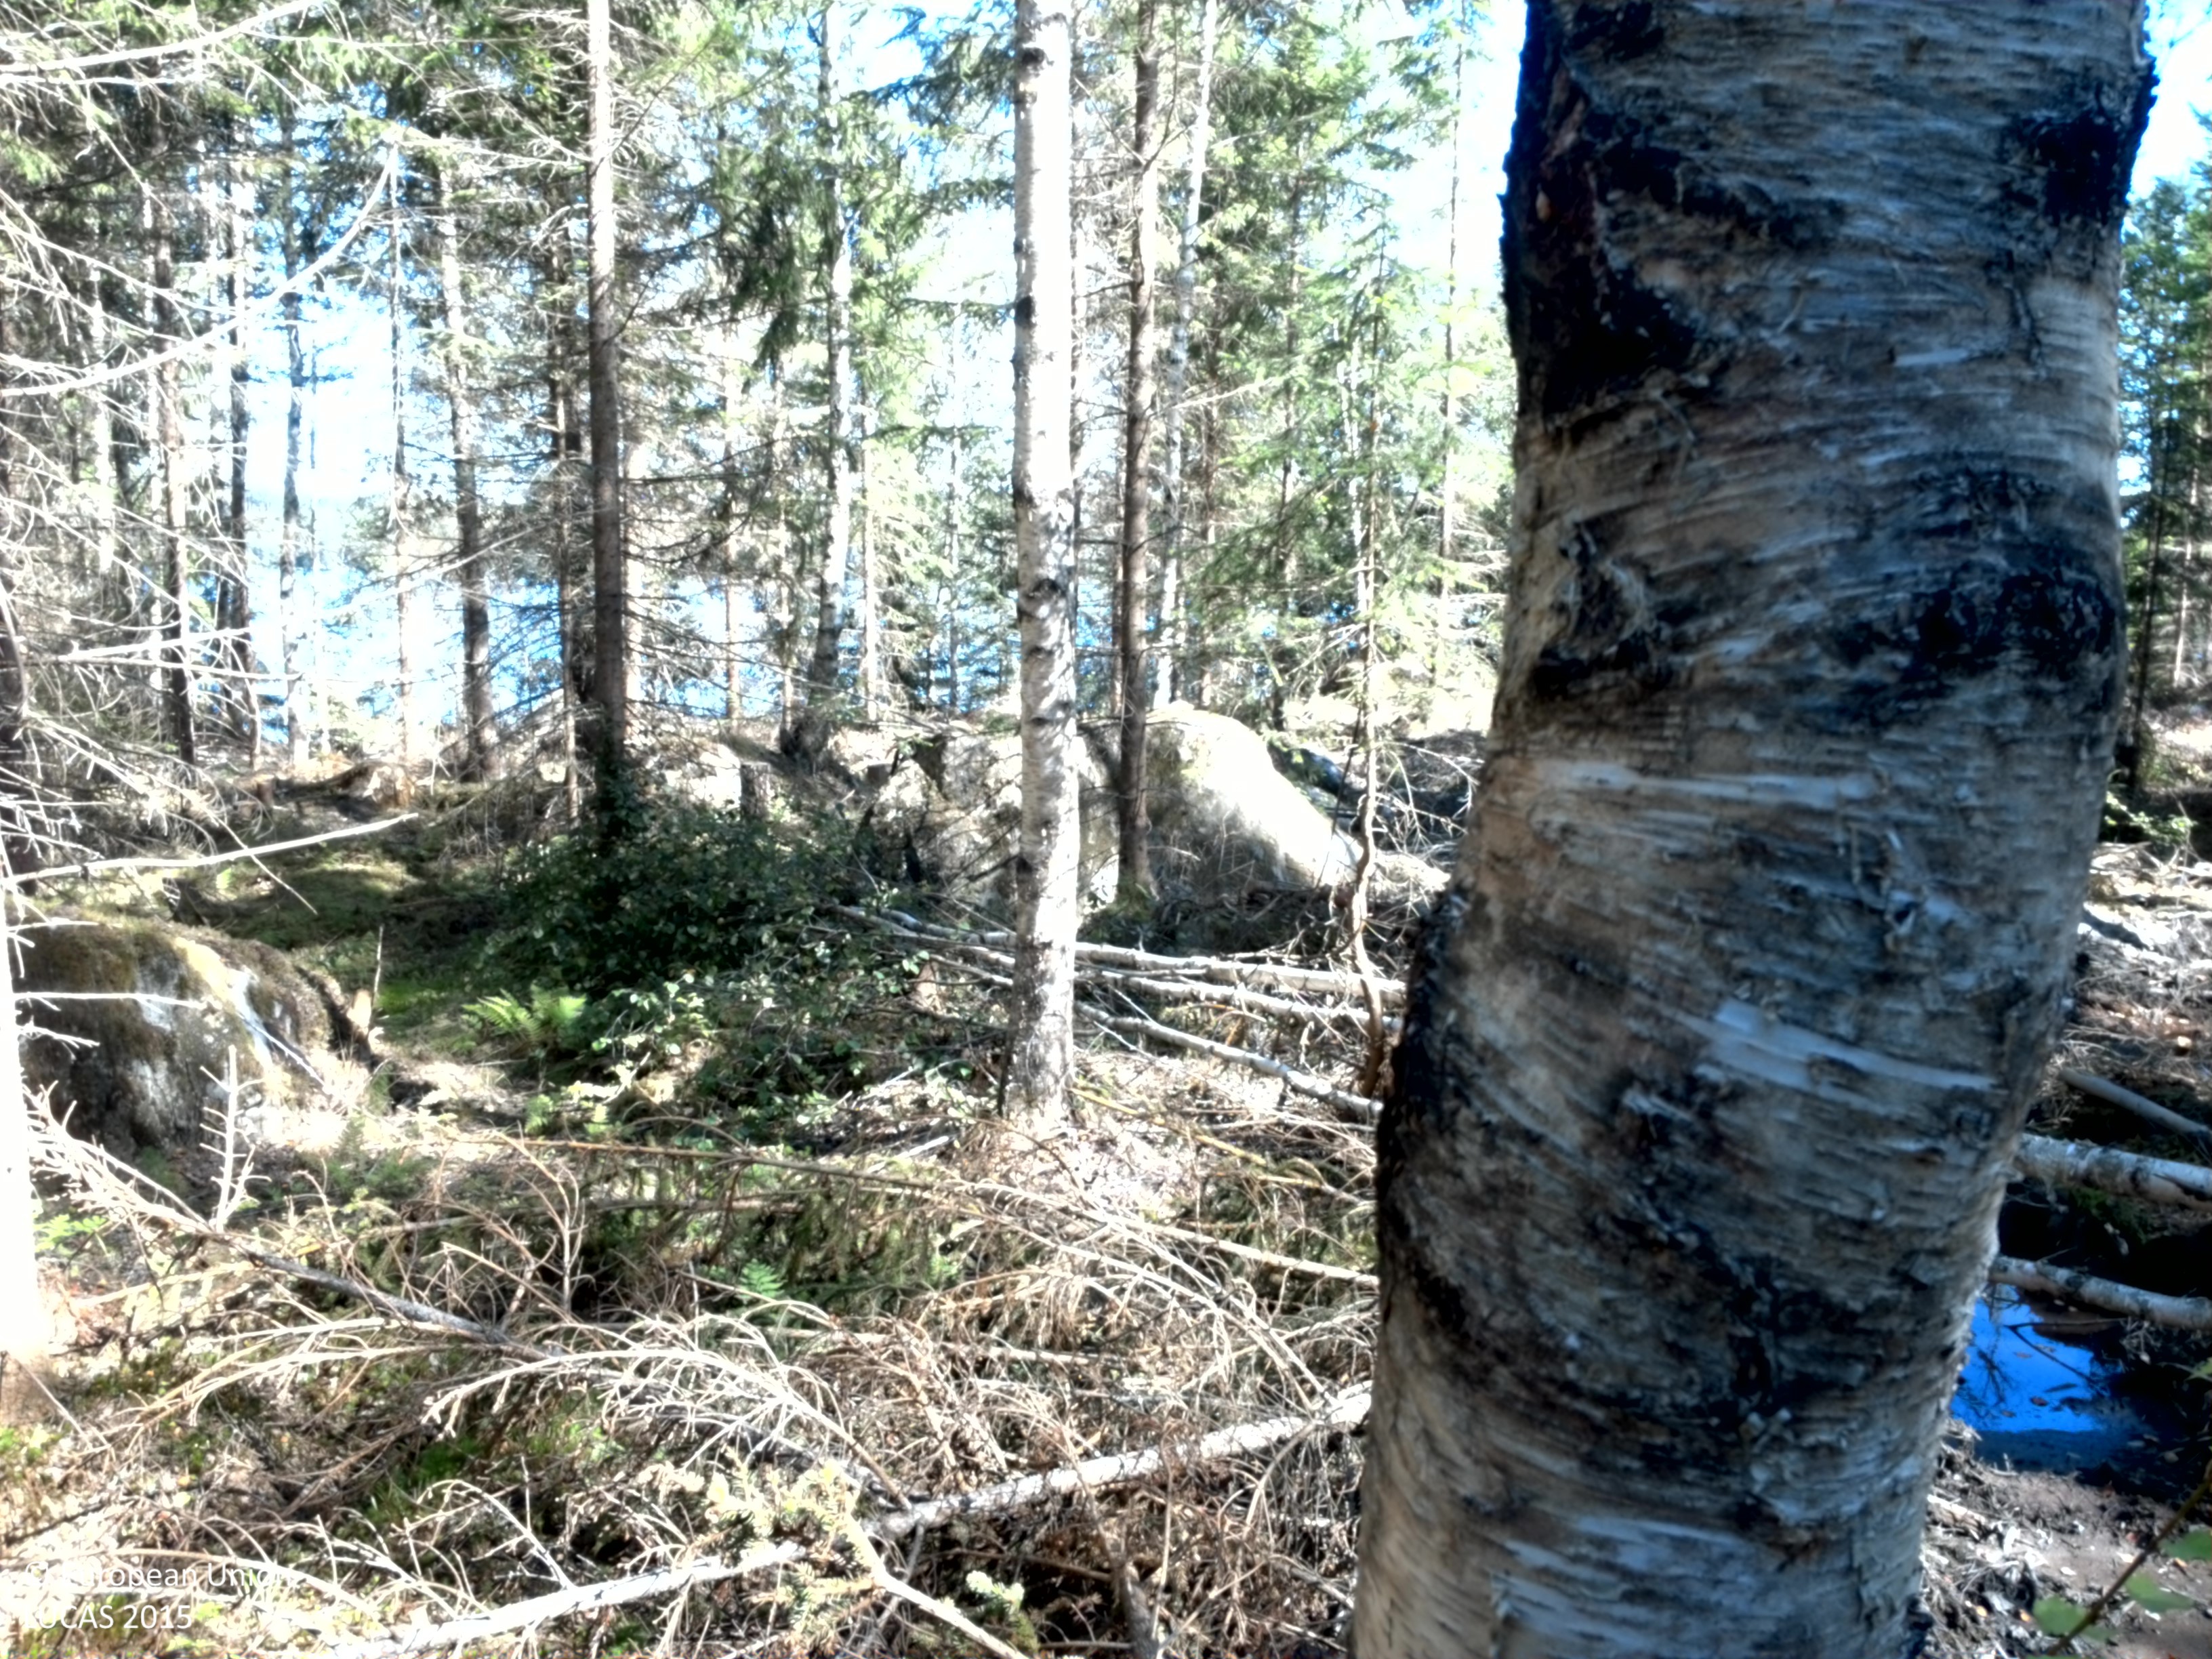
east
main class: Woodland
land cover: Spruce dominated mixed woodland
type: boreal forest
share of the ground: 50 - 75 %
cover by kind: coniferous forest trees 30 %, broadleaved forest trees 20 %, lichens and mosses 15 %, consolidated bare surface 10 %, shrubs 5 %
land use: Forestry
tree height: > 5 m
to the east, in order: Spruce dominated mixed woodland; Inland fresh water bodies
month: August
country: SE
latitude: 59.7415
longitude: 14.1360
